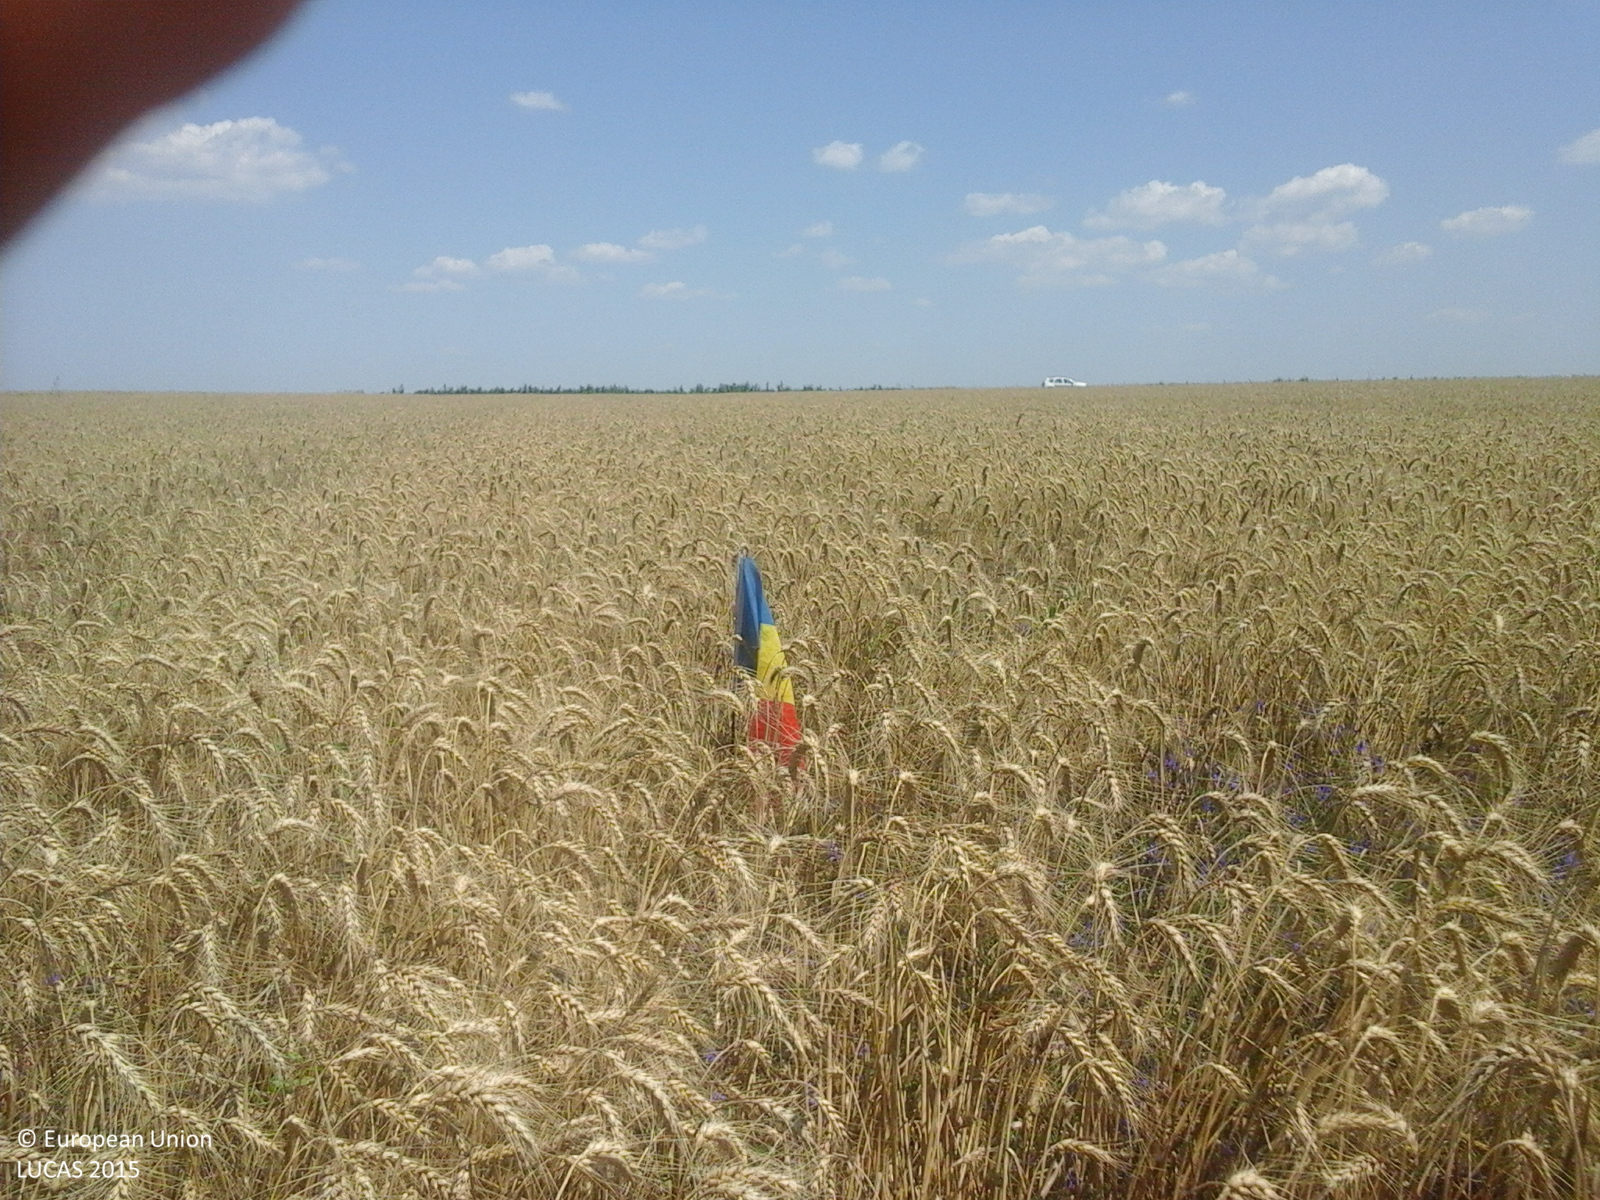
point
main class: Cropland
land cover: Common wheat
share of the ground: > 75 %
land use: Agriculture (excluding fallow land and kitchen gardens)
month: July
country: RO
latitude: 44.1660
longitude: 24.7675
